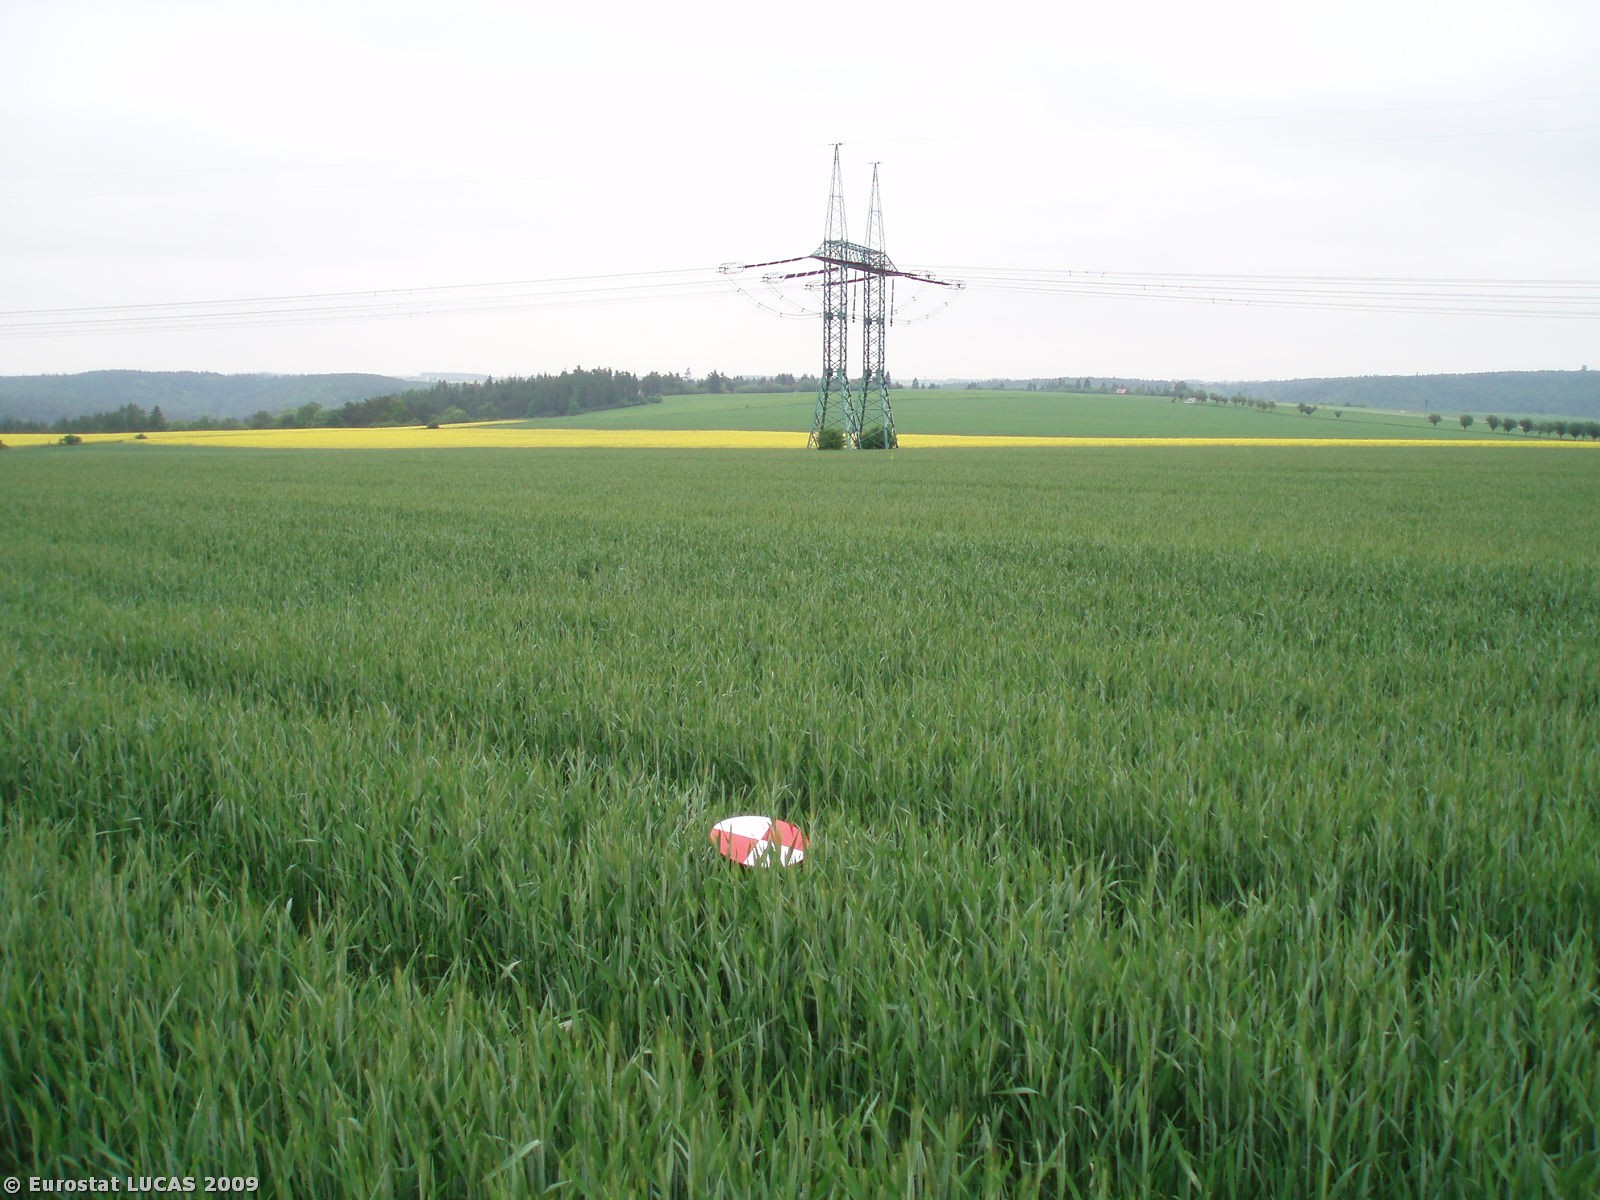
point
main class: Cropland
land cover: Rye
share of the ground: > 75 %
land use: Agriculture (excluding fallow land and kitchen gardens)
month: May
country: CZ
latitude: 50.0388
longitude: 14.0920
